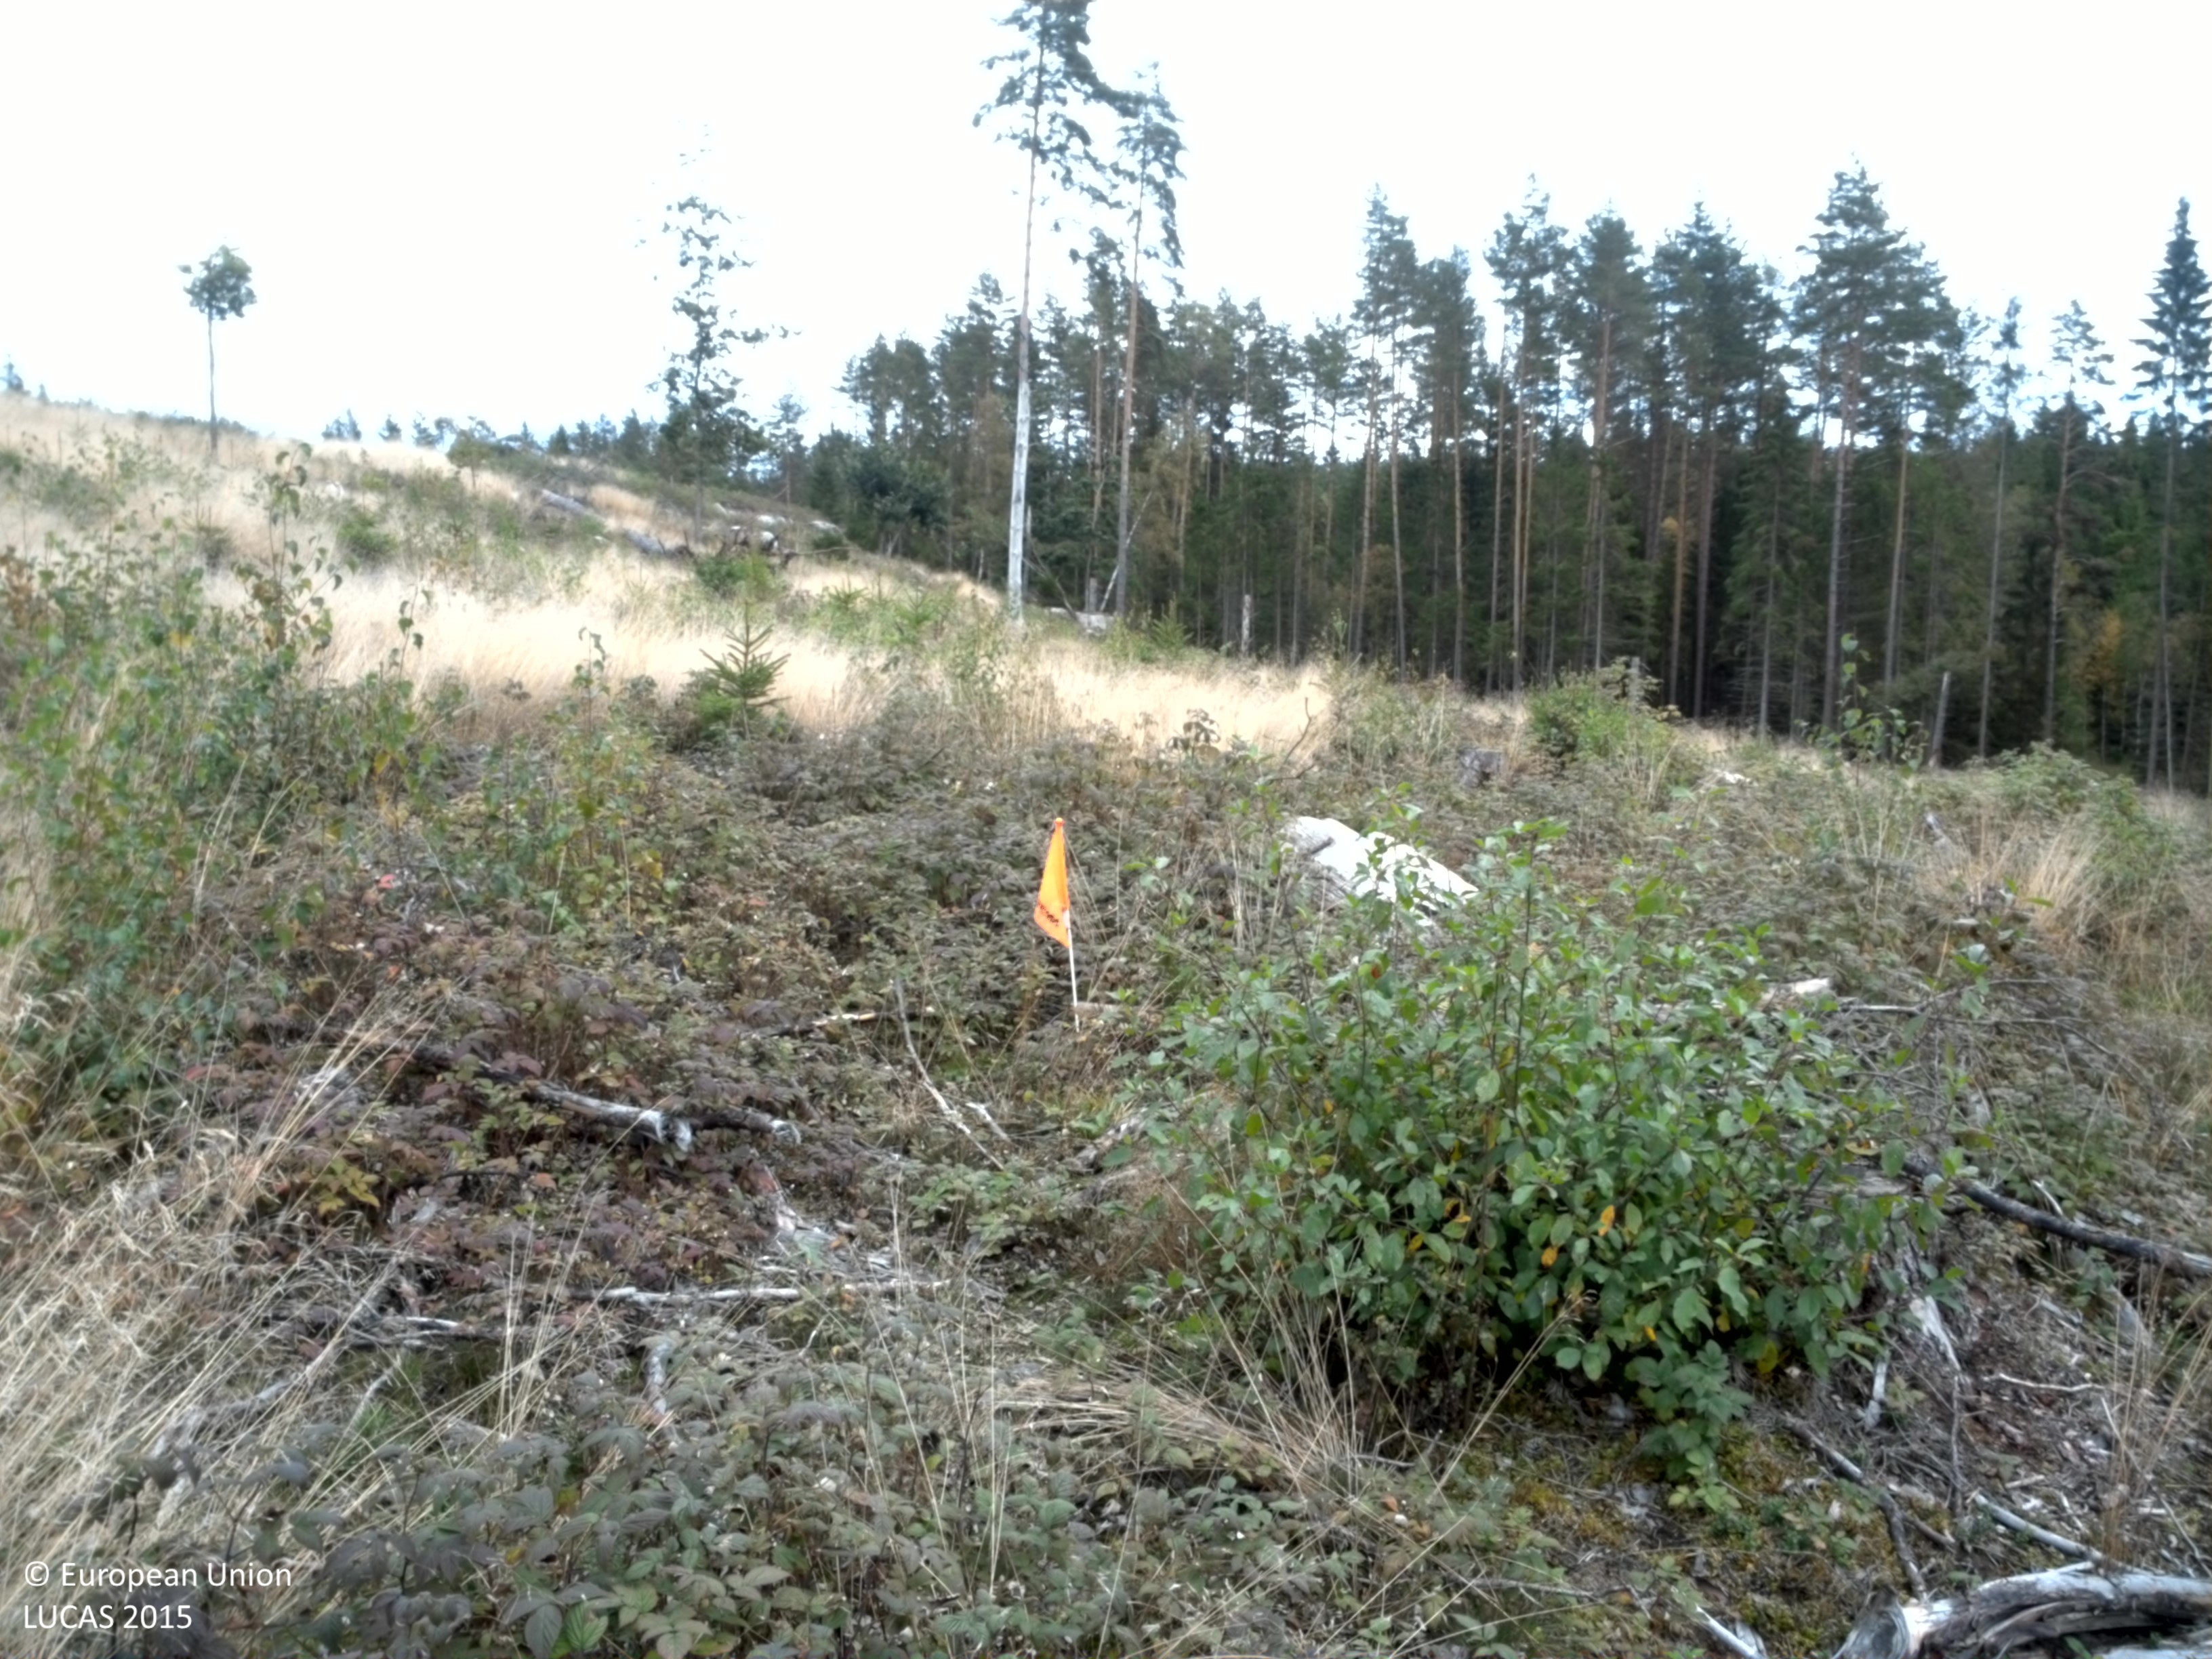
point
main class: Shrubland
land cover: Shrubland with sparse tree cover
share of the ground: 50 - 75 %
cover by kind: shrubs 75 %, herbaceous plants 15 %, coniferous forest trees 5 %, unconsolidated bare surface 5 %
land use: Forestry
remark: Clear cut
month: September
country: SE
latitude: 58.0048
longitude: 13.0579
